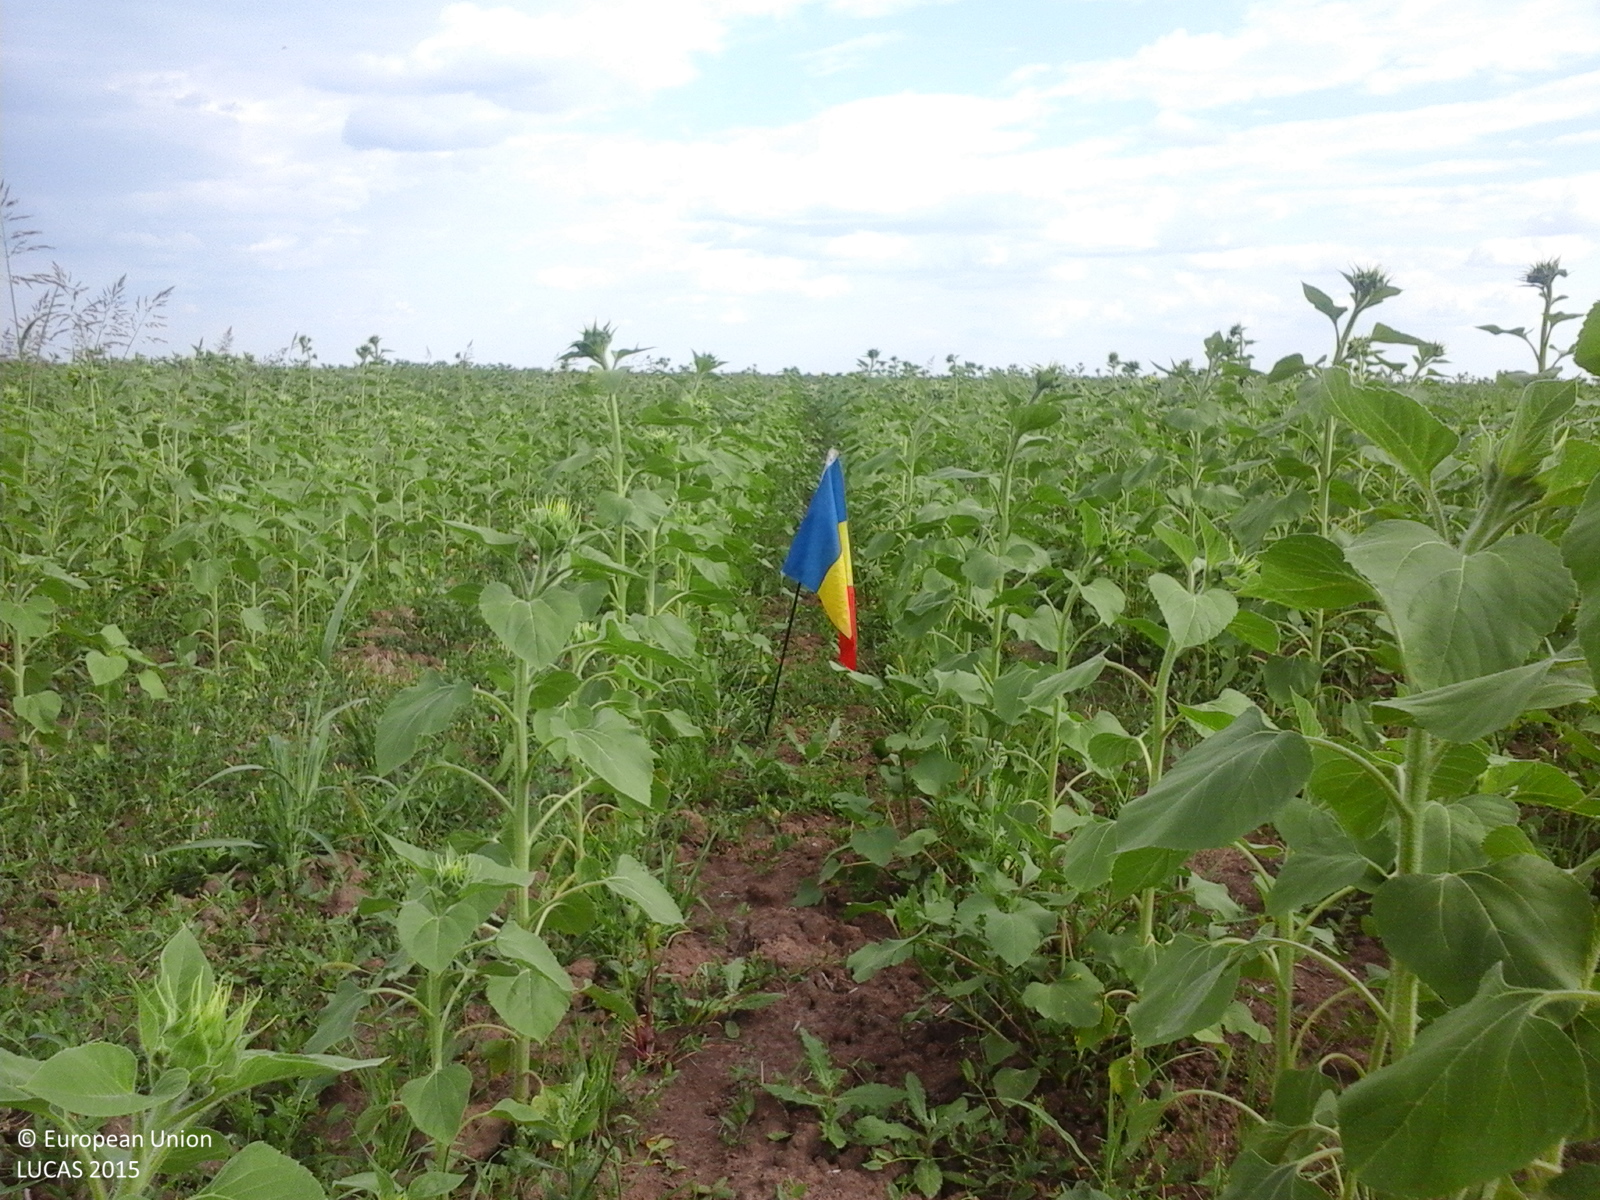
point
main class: Cropland
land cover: Sunflower
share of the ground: > 75 %
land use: Agriculture (excluding fallow land and kitchen gardens)
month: July
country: RO
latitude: 44.2252
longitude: 25.1153
